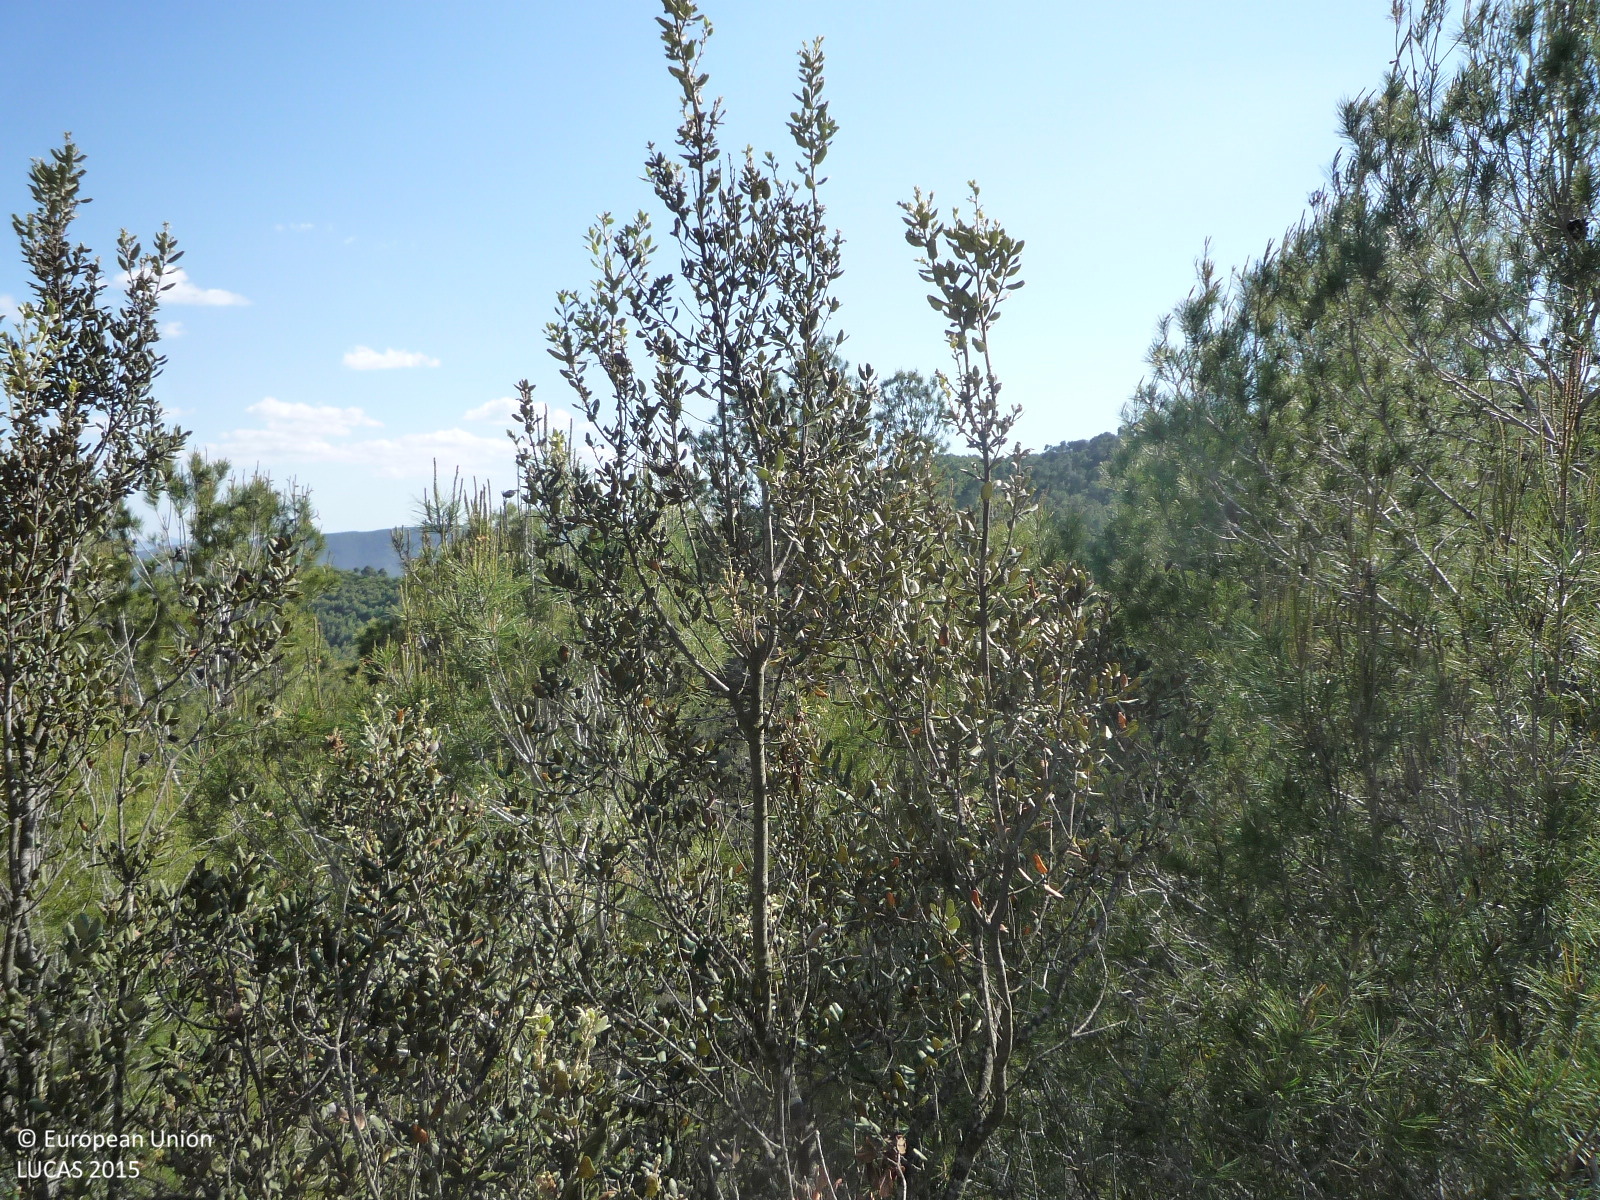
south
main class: Woodland
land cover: Pine dominated coniferous woodland
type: coniferous forest of the mediterranean region
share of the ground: > 75 %
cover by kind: coniferous forest trees 85 %, consolidated bare surface 10 %, broadleaved forest trees 5 %
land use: Semi-natural and natural areas not in use
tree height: > 5 m
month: May
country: ES
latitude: 41.8802
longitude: 1.7355
